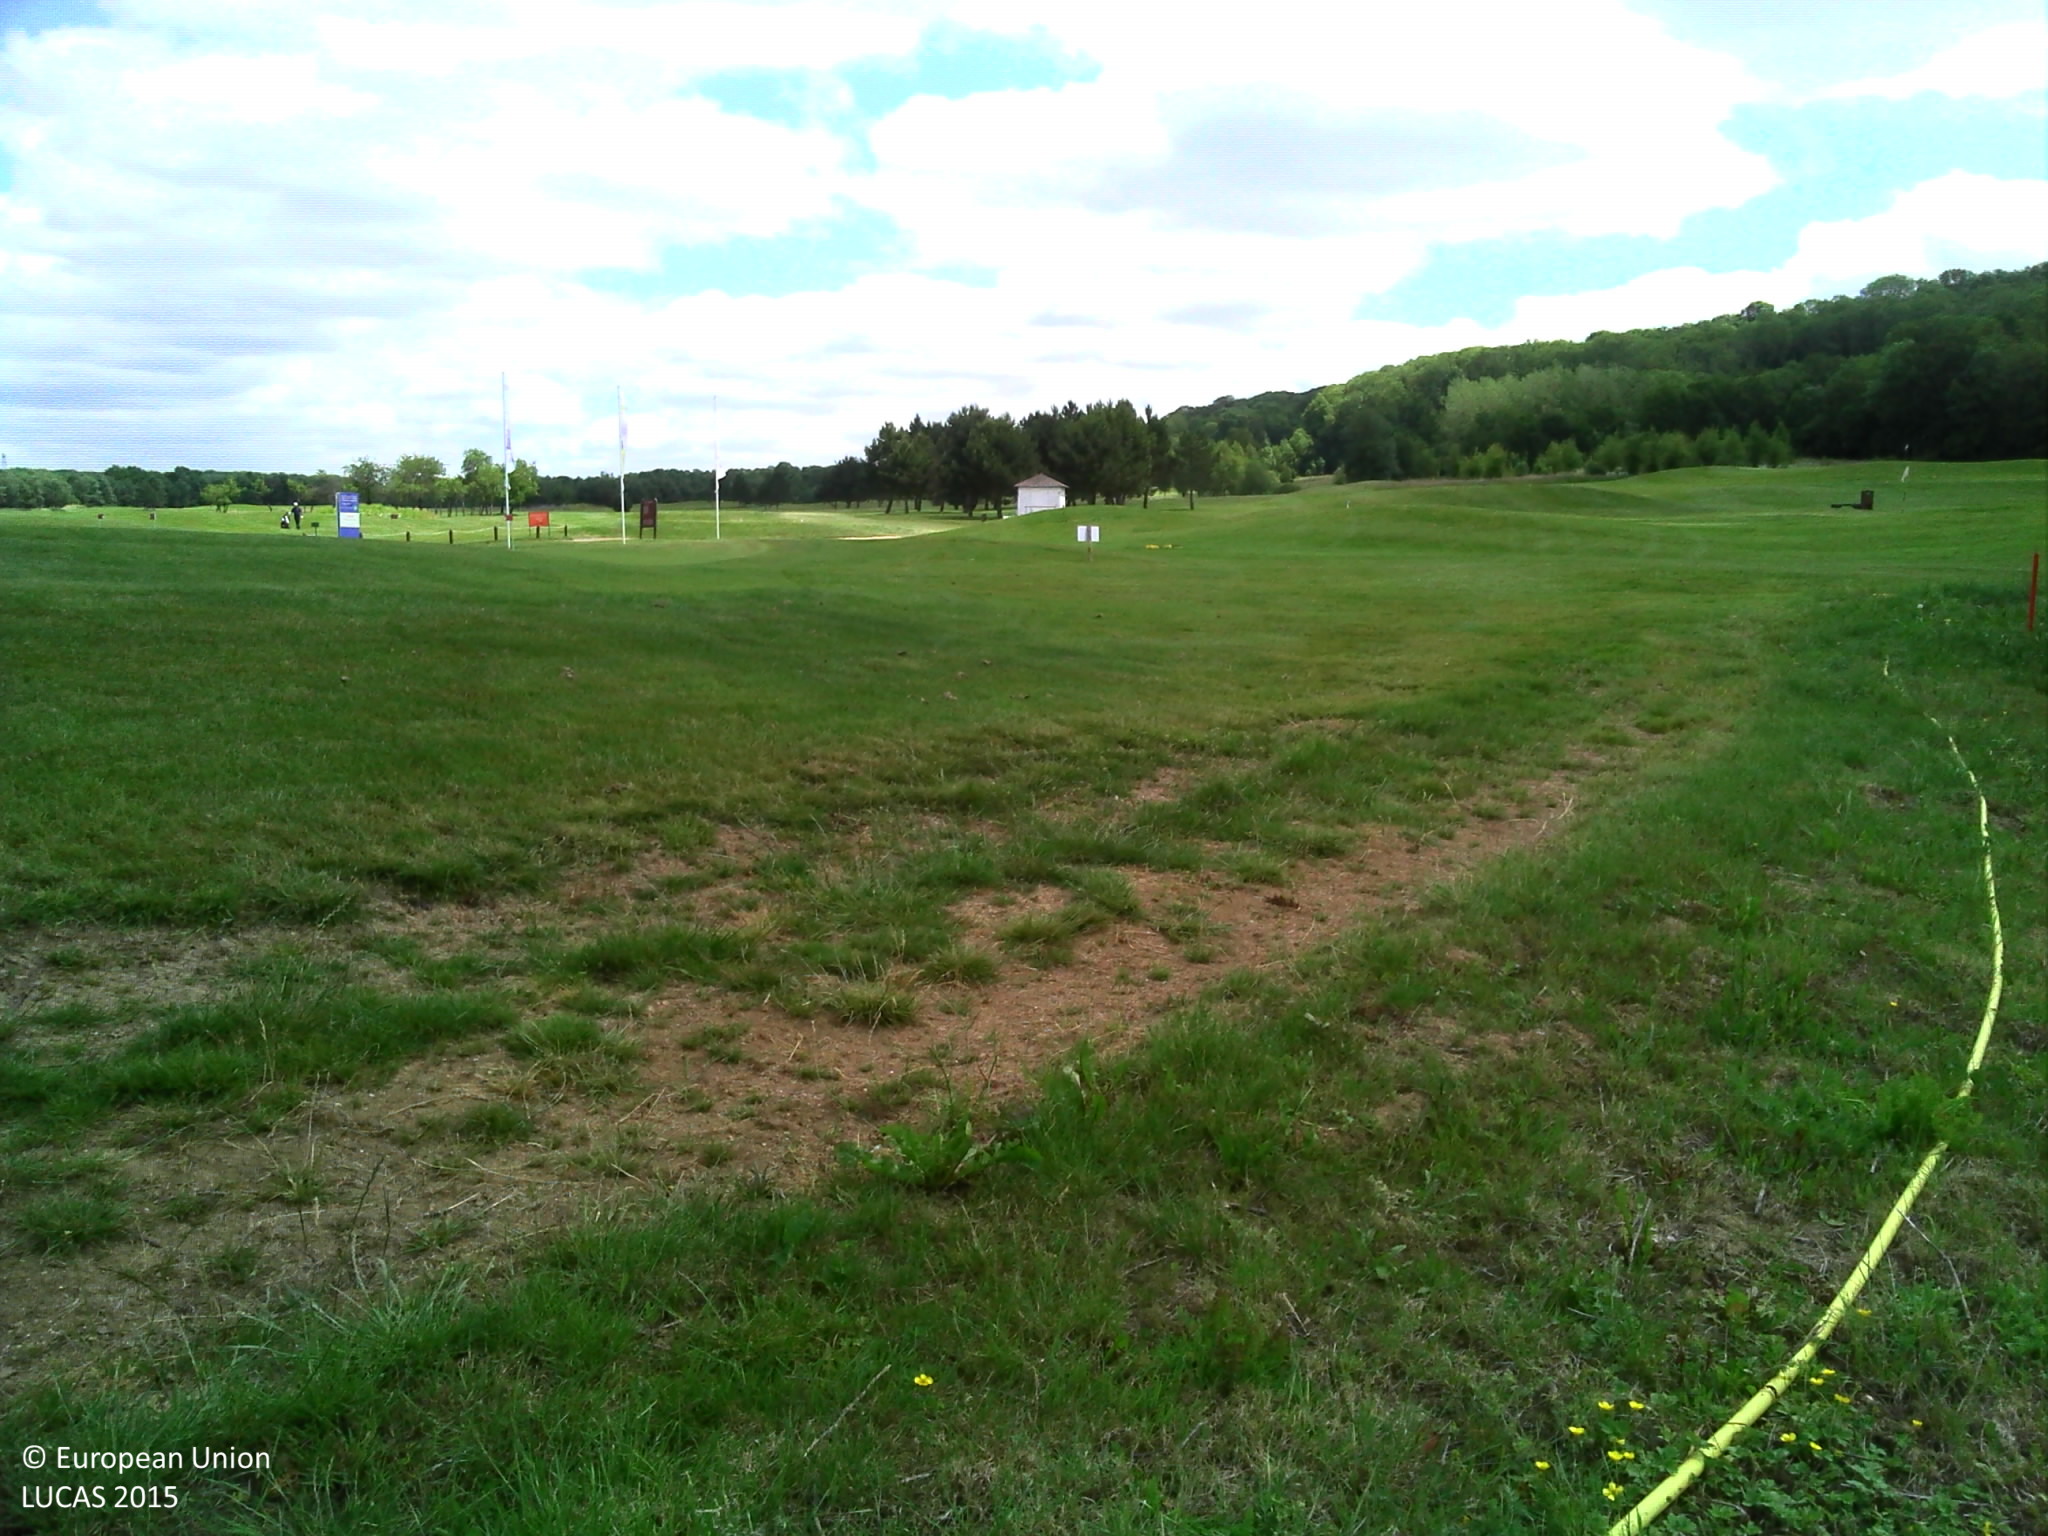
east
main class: Grassland
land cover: Grassland without tree/shrub cover
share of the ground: > 75 %
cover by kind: herbaceous plants 100 %
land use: Amenities, museums, leisure
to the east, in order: Grassland without tree/shrub cover; Tracks; Grassland without tree/shrub cover; Pine dominated coniferous woodland; Grassland without tree/shrub cover; Grassland with sparse tree/shrub cover
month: June
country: FR
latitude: 48.7006
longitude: 6.2635
